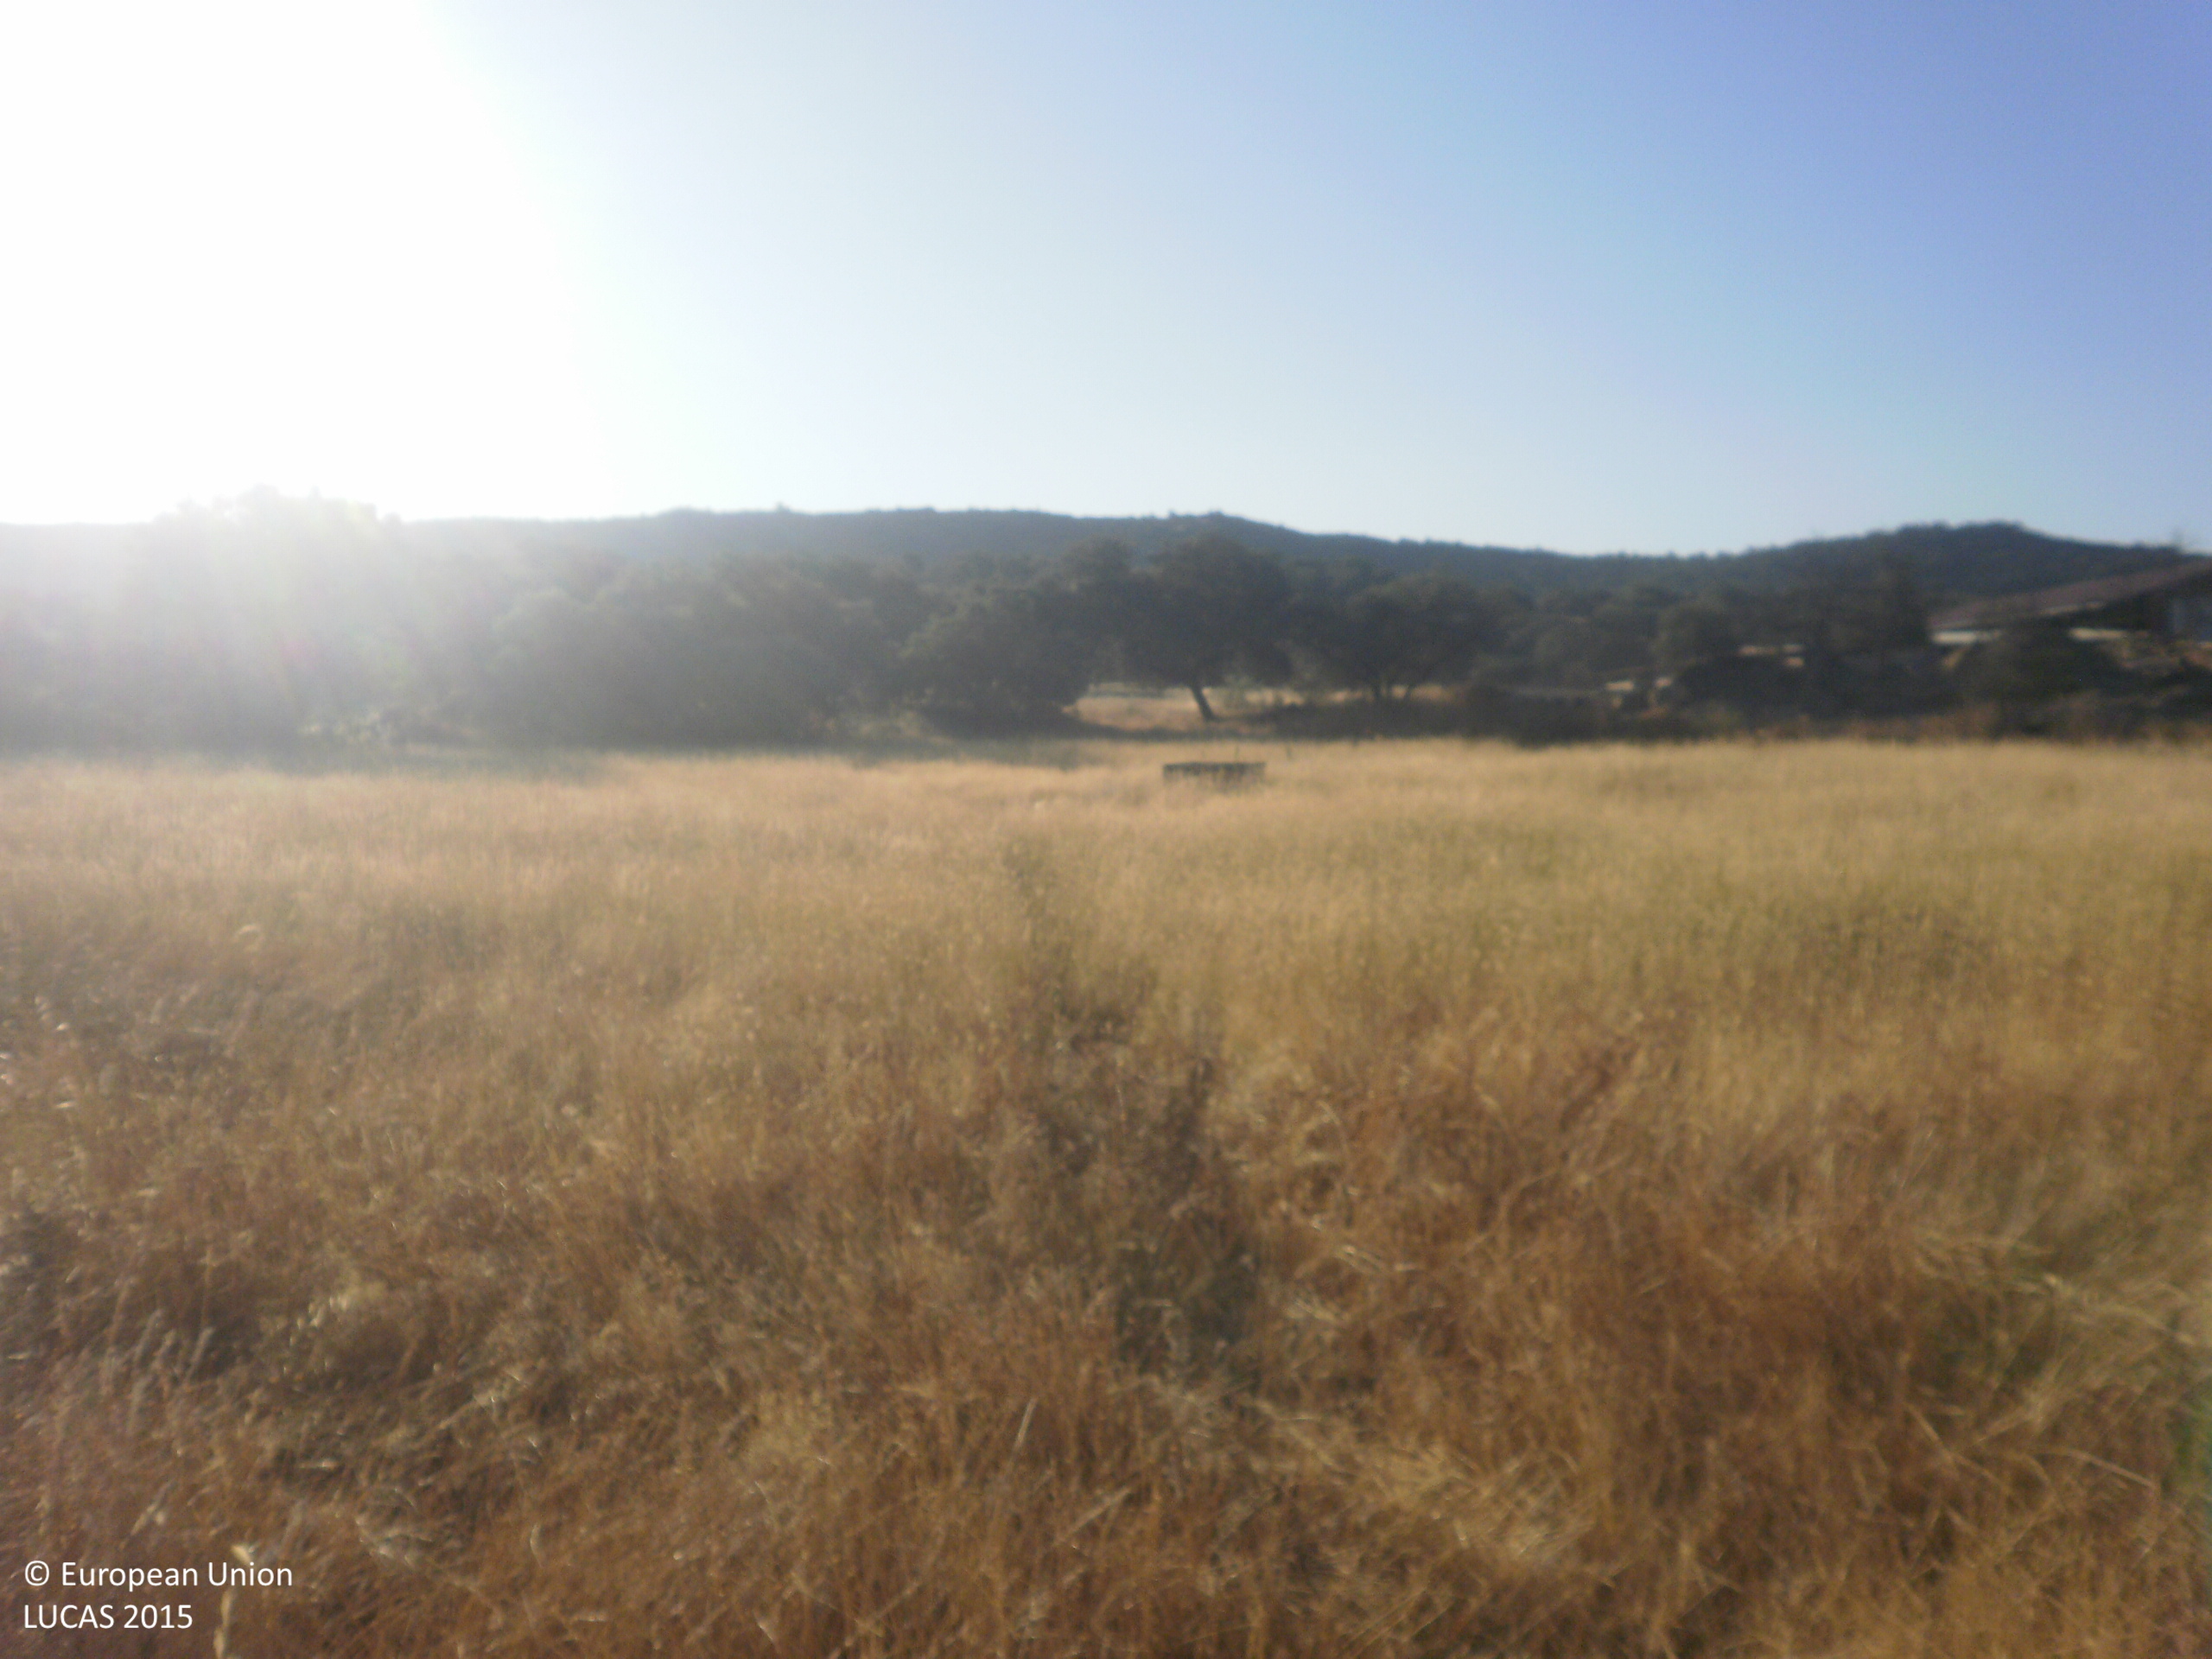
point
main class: Woodland
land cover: Broadleaved woodland
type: broadleaved evergreen forest
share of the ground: 50 - 75 %
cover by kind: broadleaved forest trees 100 %
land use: Agriculture (excluding fallow land and kitchen gardens)
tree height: > 5 m
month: June
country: ES
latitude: 39.2728
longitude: -6.0189
